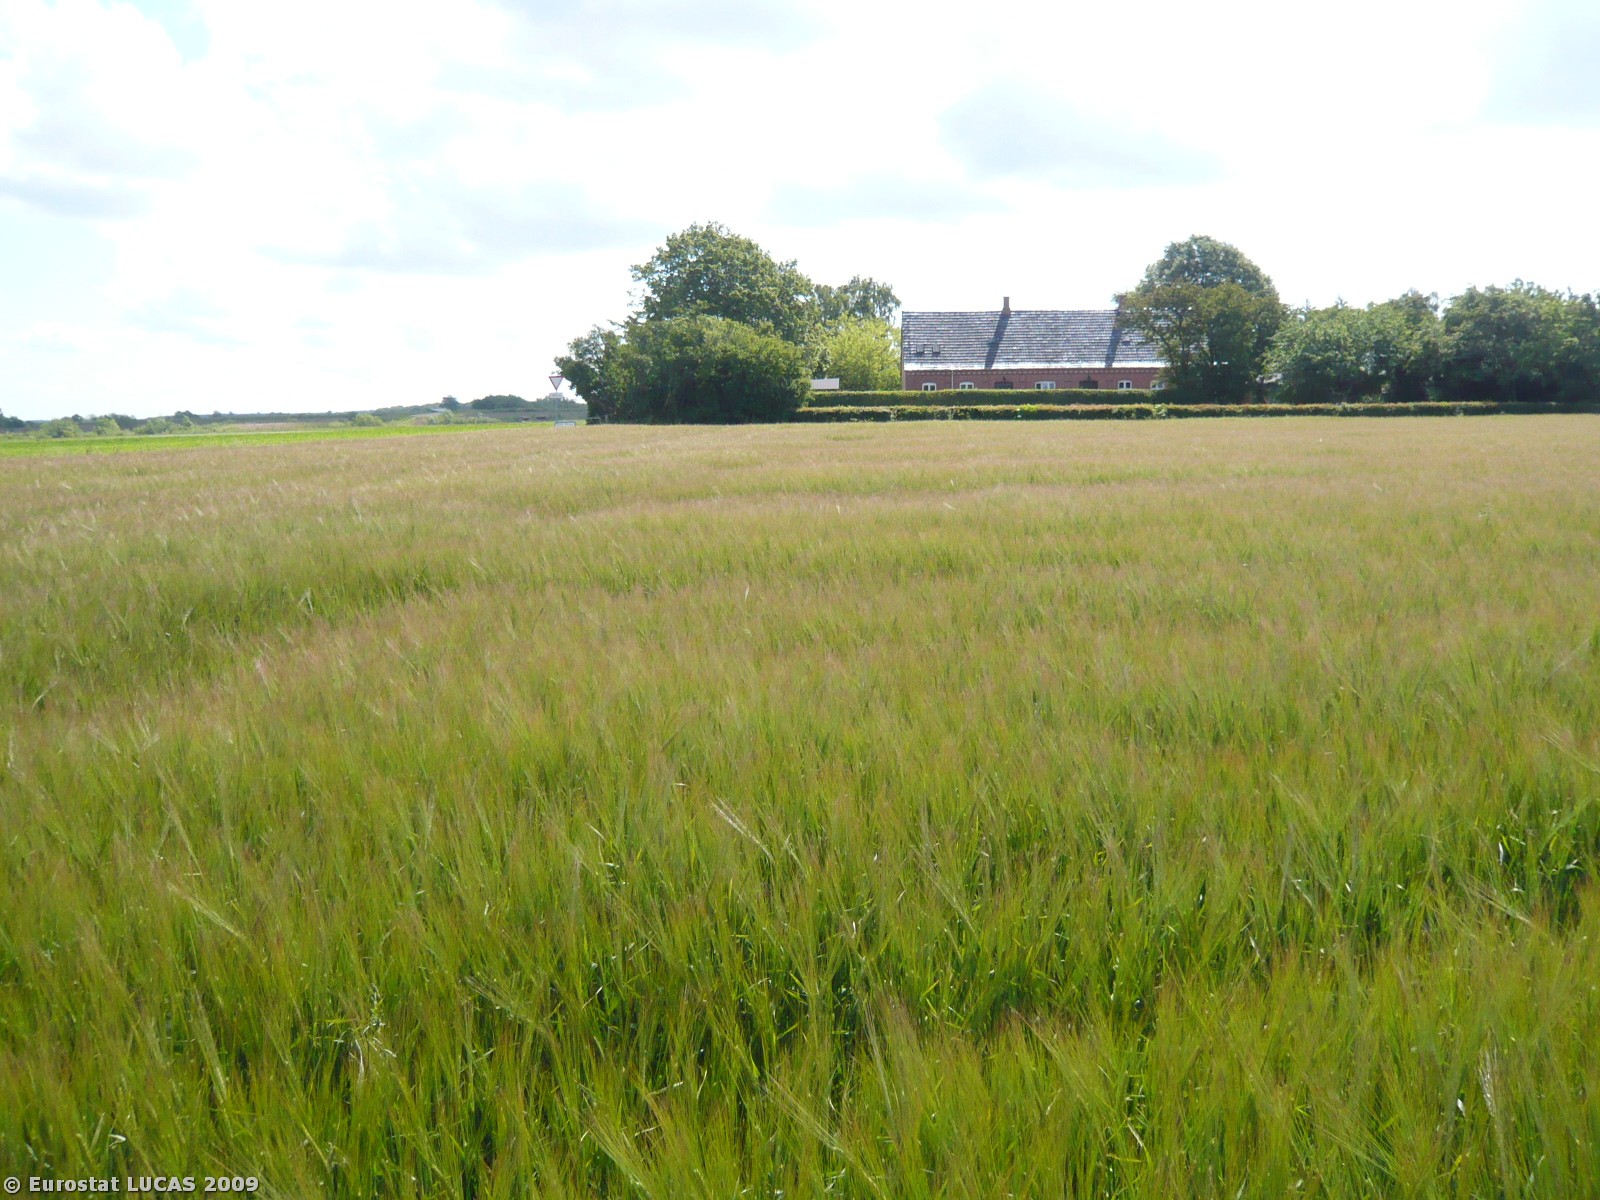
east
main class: Cropland
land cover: Barley
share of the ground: > 75 %
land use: Agriculture (excluding fallow land and kitchen gardens)
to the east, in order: Barley; Broadleaved woodland; Fences; Grass margins; Paved roads, cycling and walking lanes; Grass margins; Sugar beet; Grass margins; Paved roads, cycling and walking lanes; Grassland without tree/shrub cover; Shrubland with sparse tree cover; Inland water bodies
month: June
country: DK
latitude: 54.7208
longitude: 11.6601
